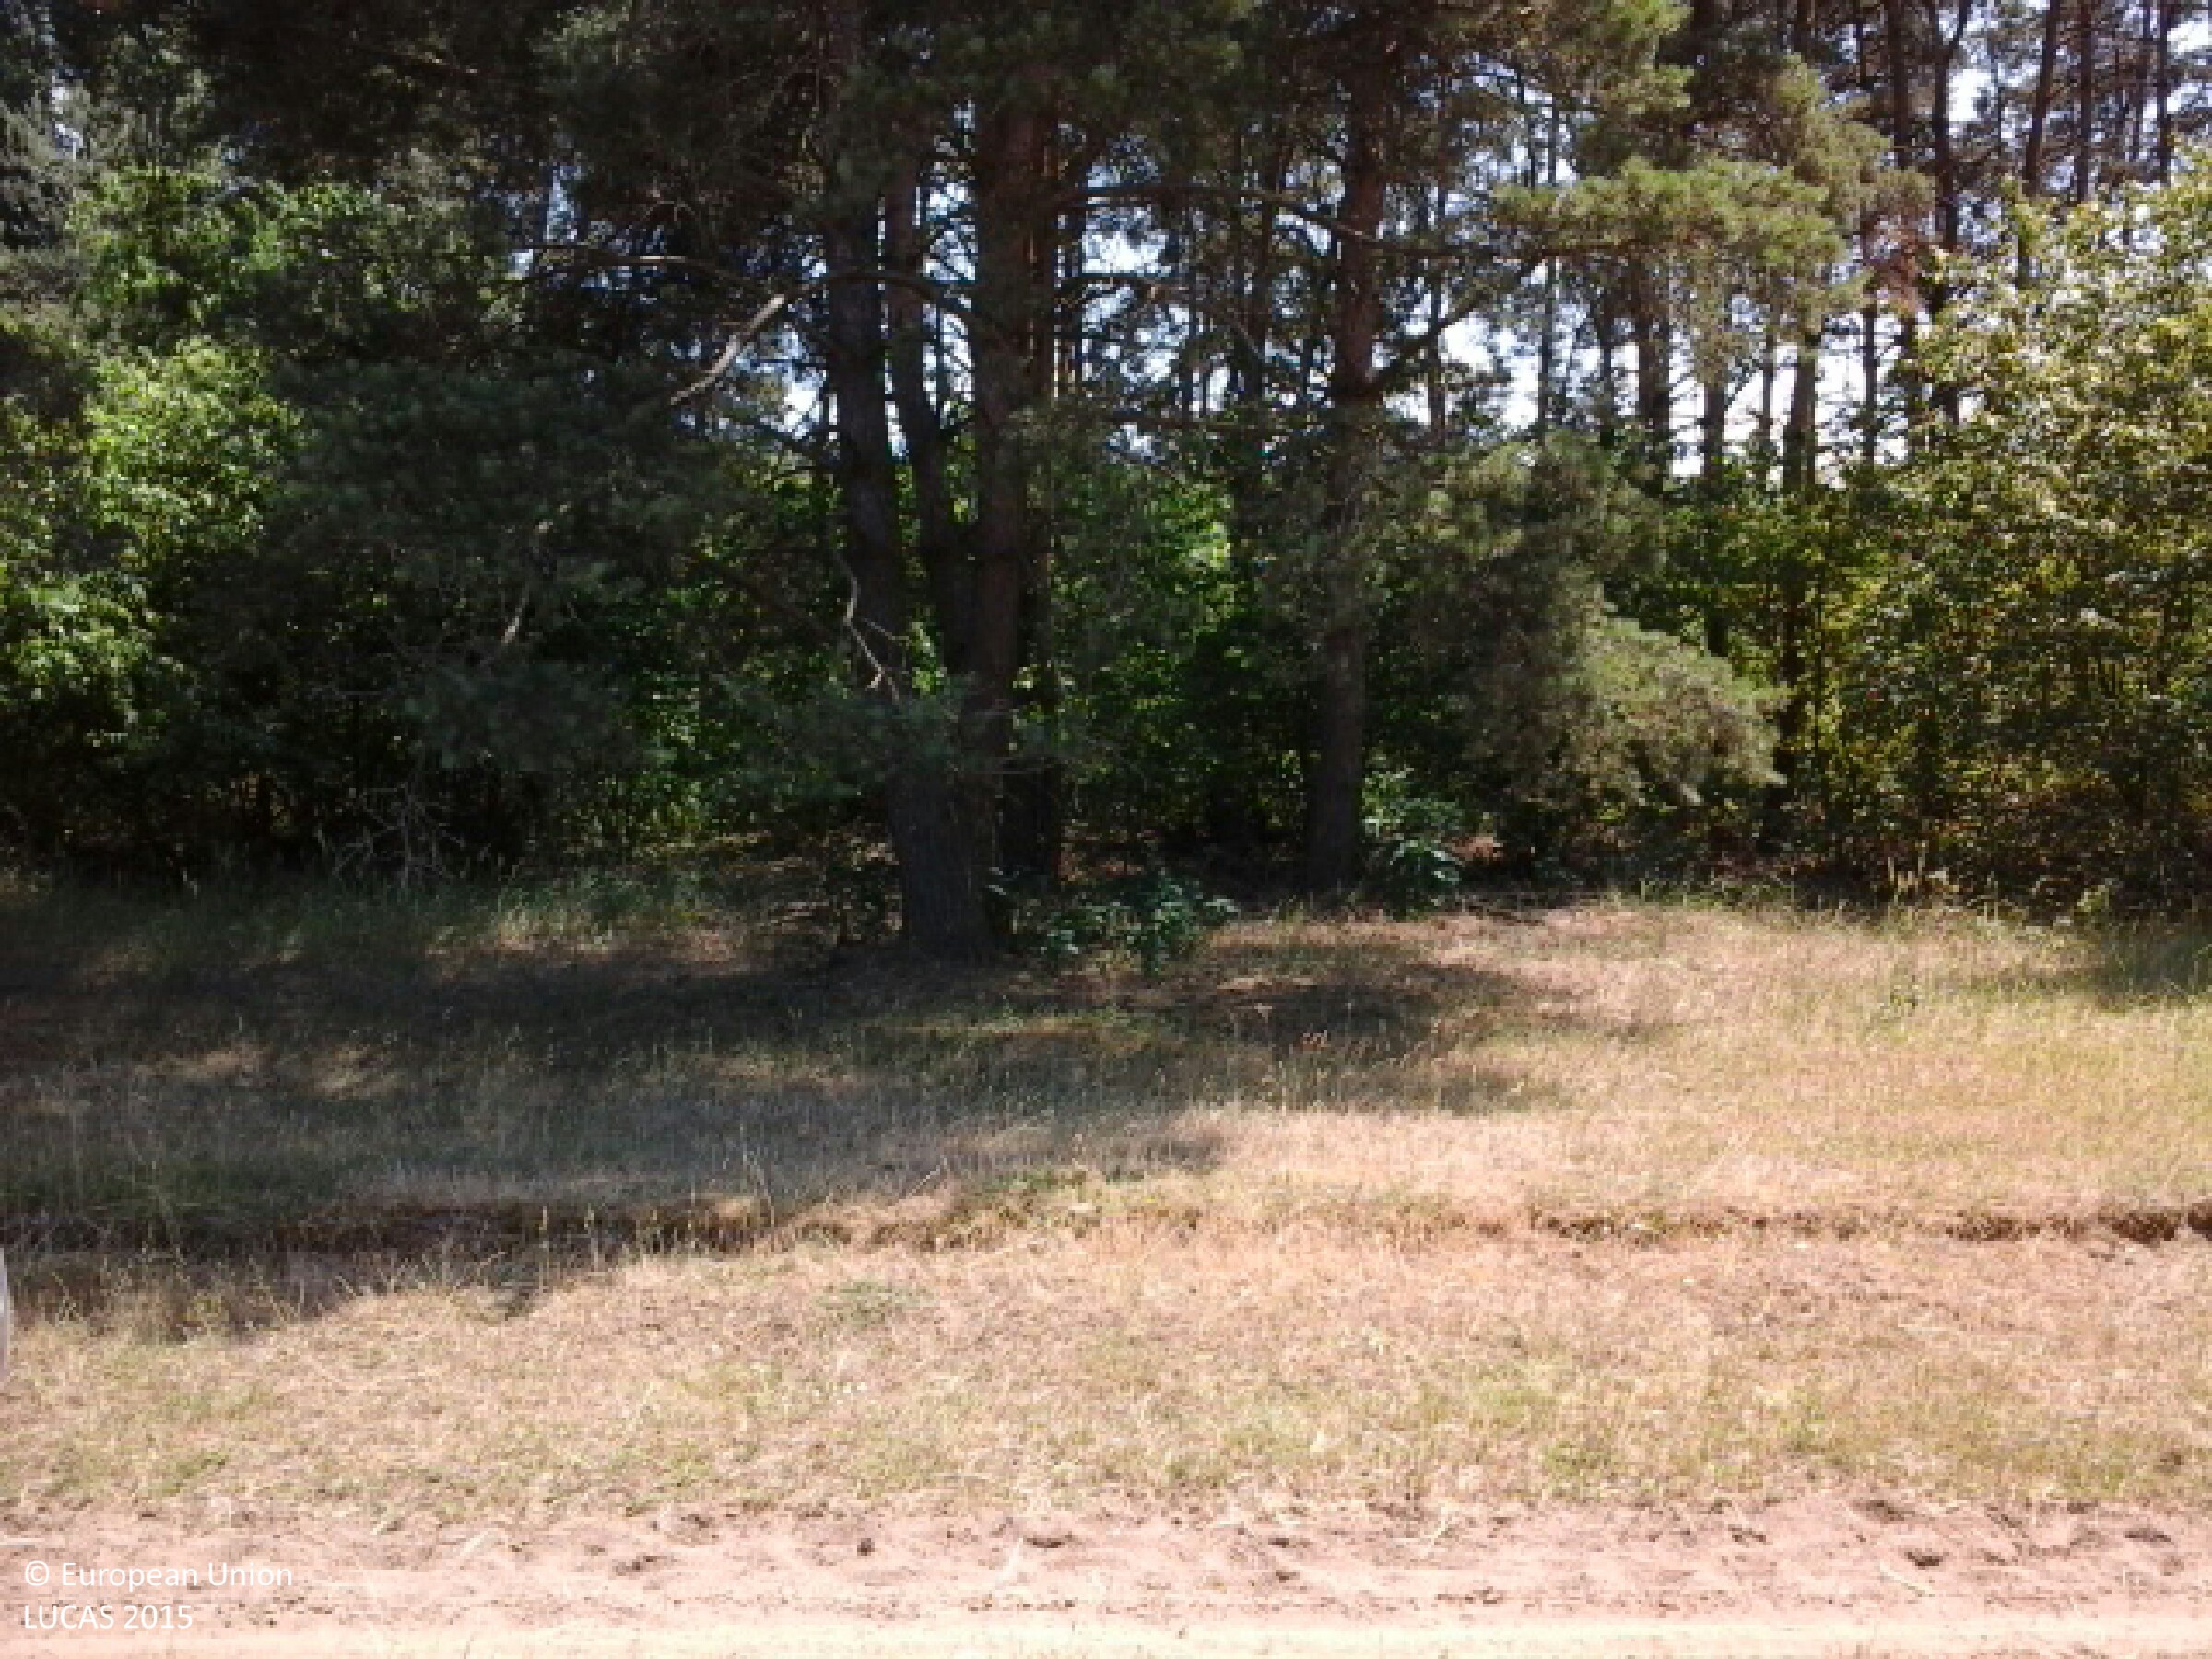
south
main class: Cropland
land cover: Other fresh vegetables
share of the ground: 10 - 25 %
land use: Agriculture (excluding fallow land and kitchen gardens)
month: June
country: HU
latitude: 47.8745
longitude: 21.6656
